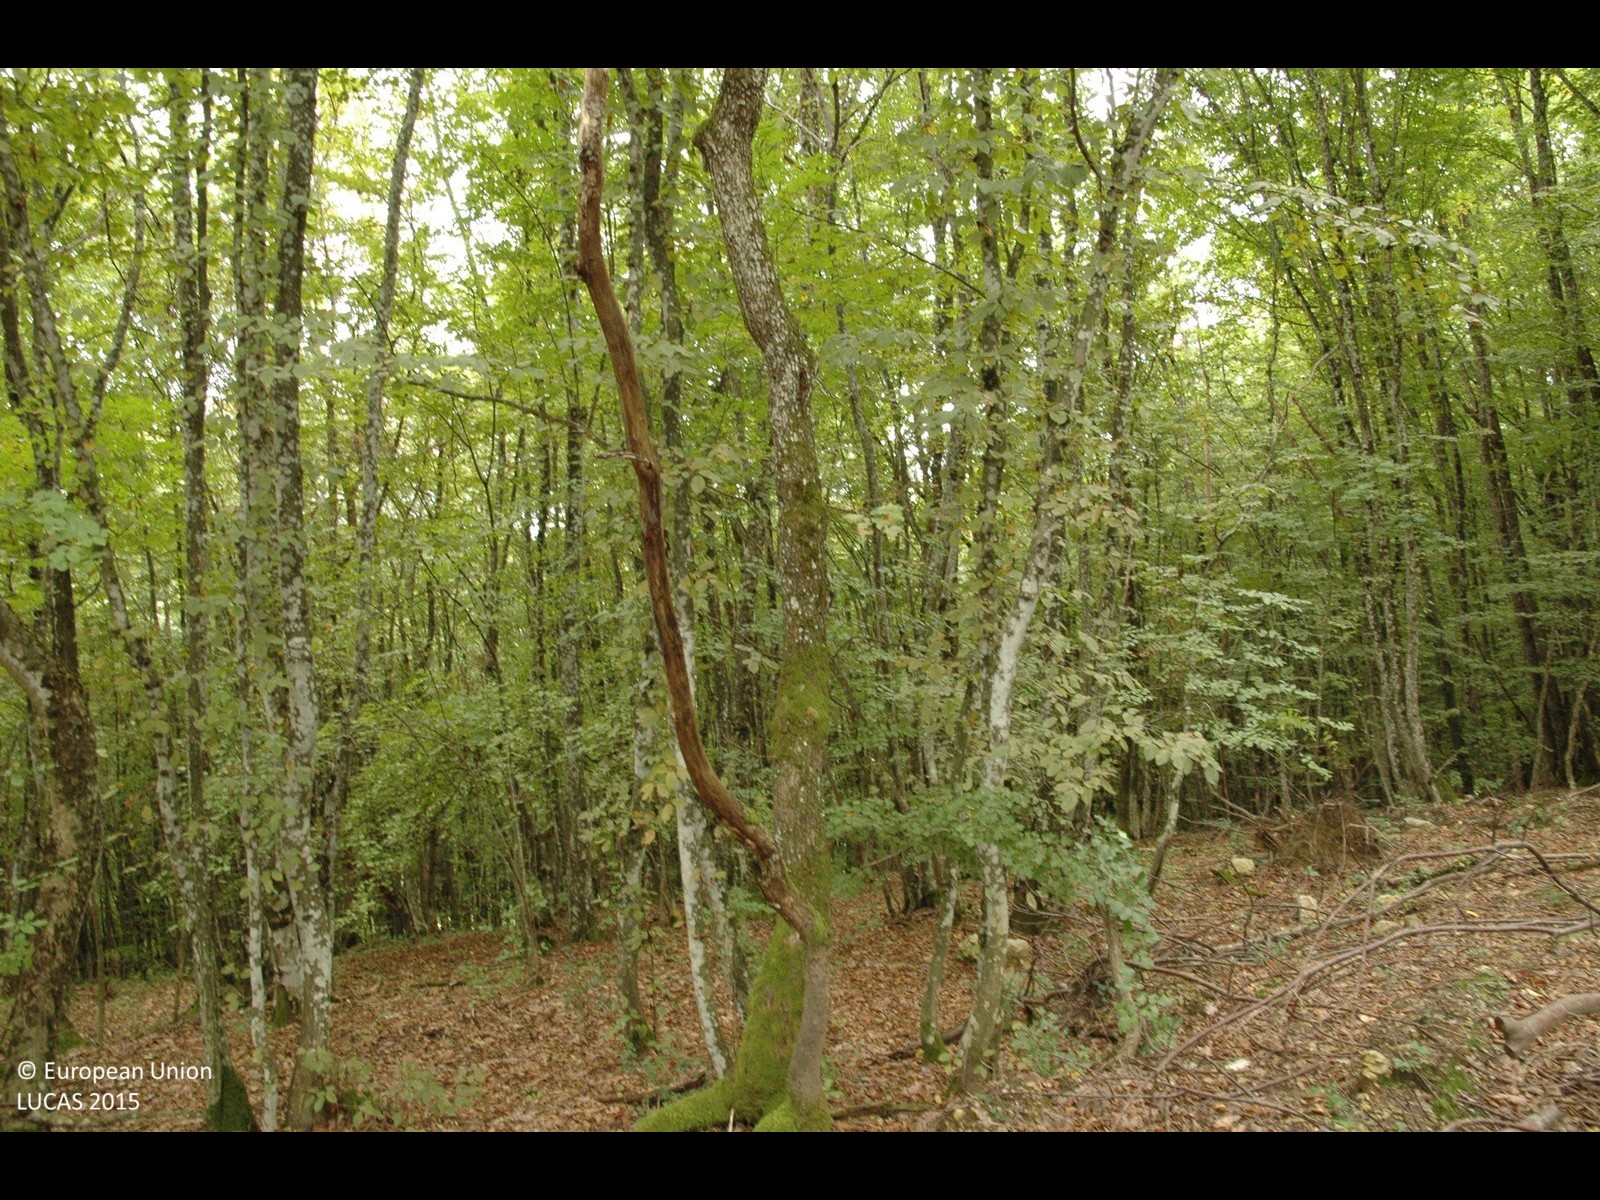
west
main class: Woodland
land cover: Broadleaved woodland
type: mesophytic deciduous forest
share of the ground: > 75 %
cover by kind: broadleaved forest trees 100 %
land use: Forestry
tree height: > 5 m
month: September
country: HR
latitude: 45.2646
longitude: 15.6161
